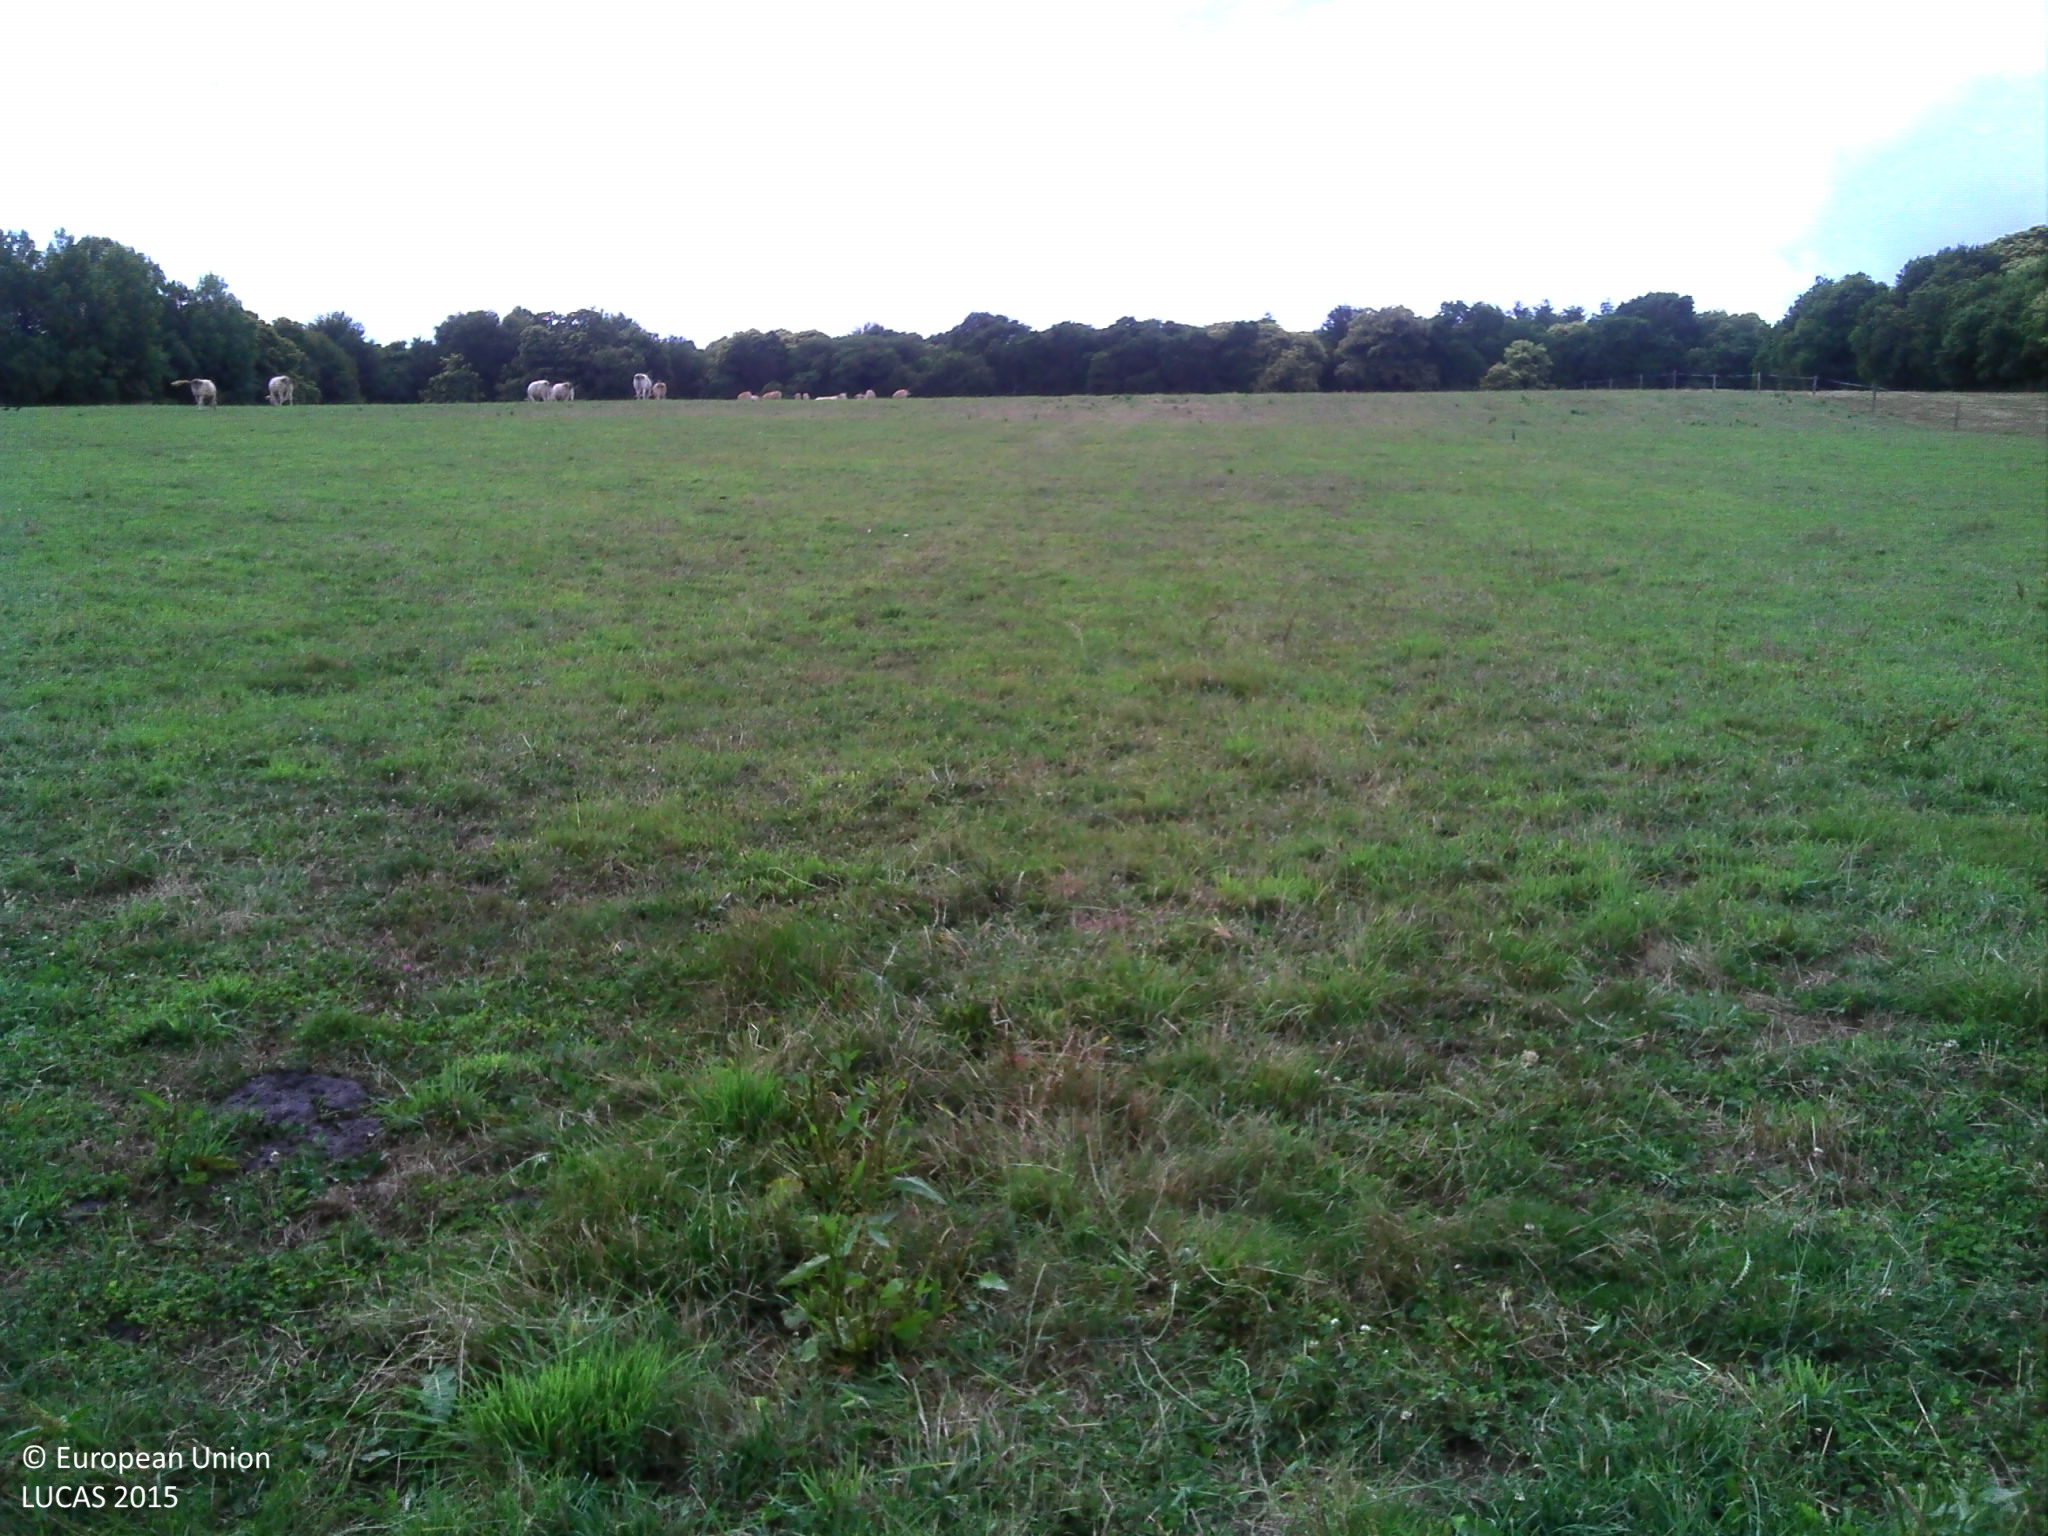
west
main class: Grassland
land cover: Grassland without tree/shrub cover
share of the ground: > 75 %
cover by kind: herbaceous plants 80 %, consolidated bare surface 20 %
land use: Agriculture (excluding fallow land and kitchen gardens)
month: July
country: FR
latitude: 47.8085
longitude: -3.4957
